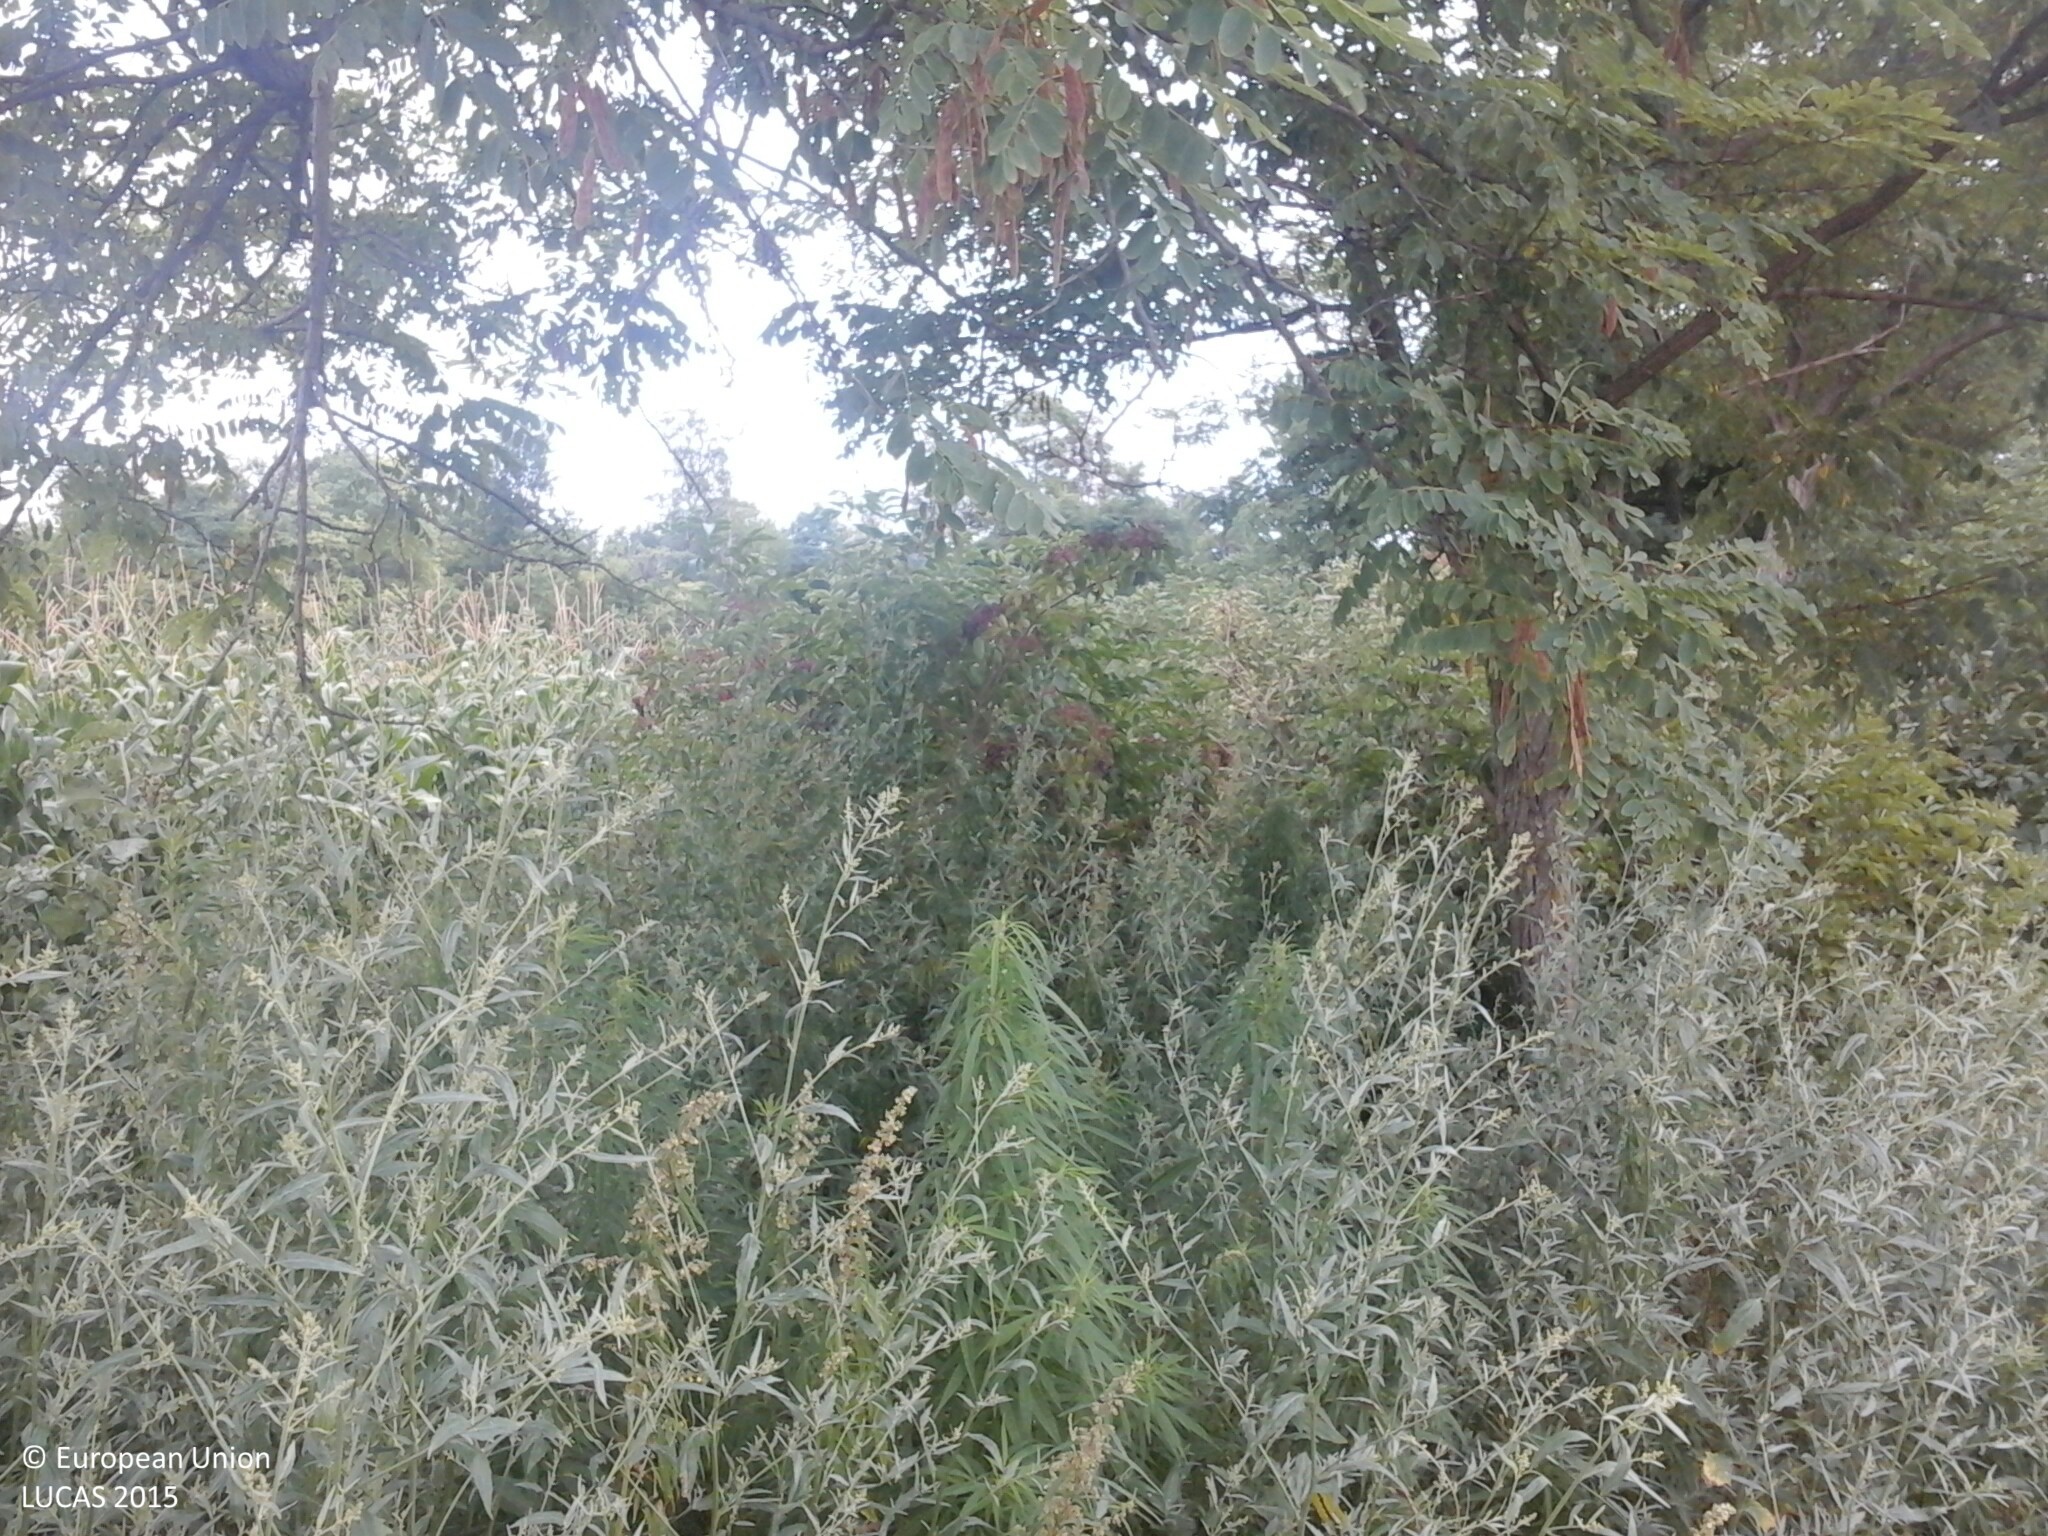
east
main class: Cropland
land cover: Maize
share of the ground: > 75 %
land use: Agriculture (excluding fallow land and kitchen gardens)
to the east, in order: Maize; Broadleaved woodland; Maize
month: July
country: HU
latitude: 46.9589
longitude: 18.4350
